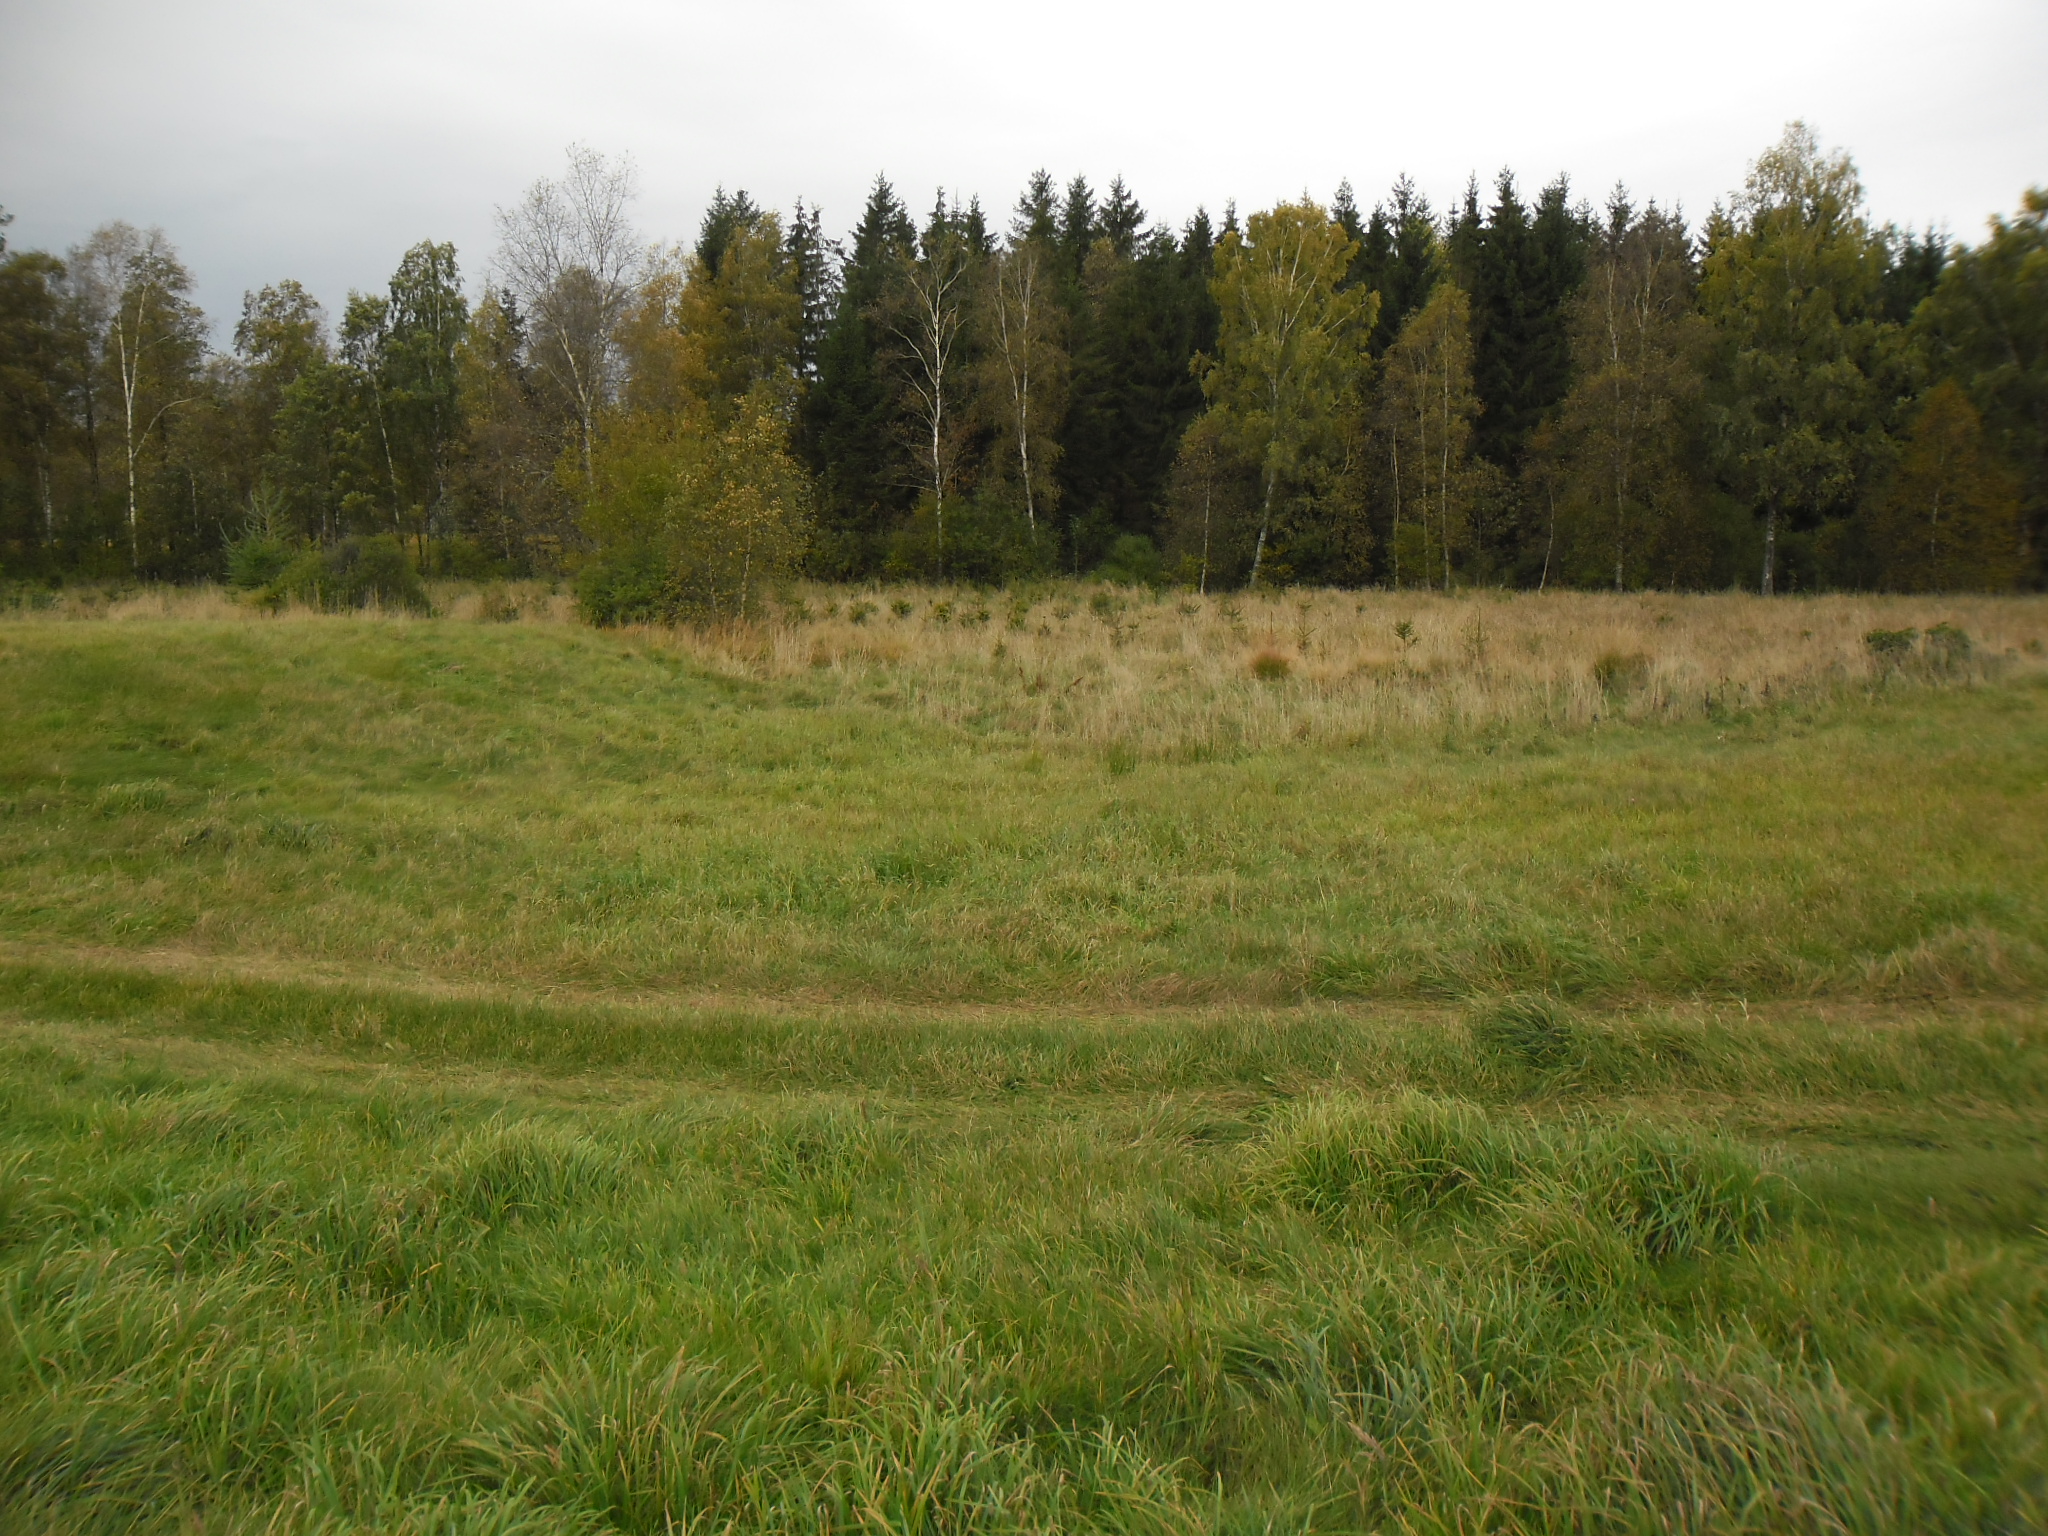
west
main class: Grassland
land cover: Grassland without tree/shrub cover
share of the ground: > 75 %
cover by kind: herbaceous plants 100 %
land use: Agriculture (excluding fallow land and kitchen gardens)
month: October
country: SE
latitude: 56.5617
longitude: 13.2025
